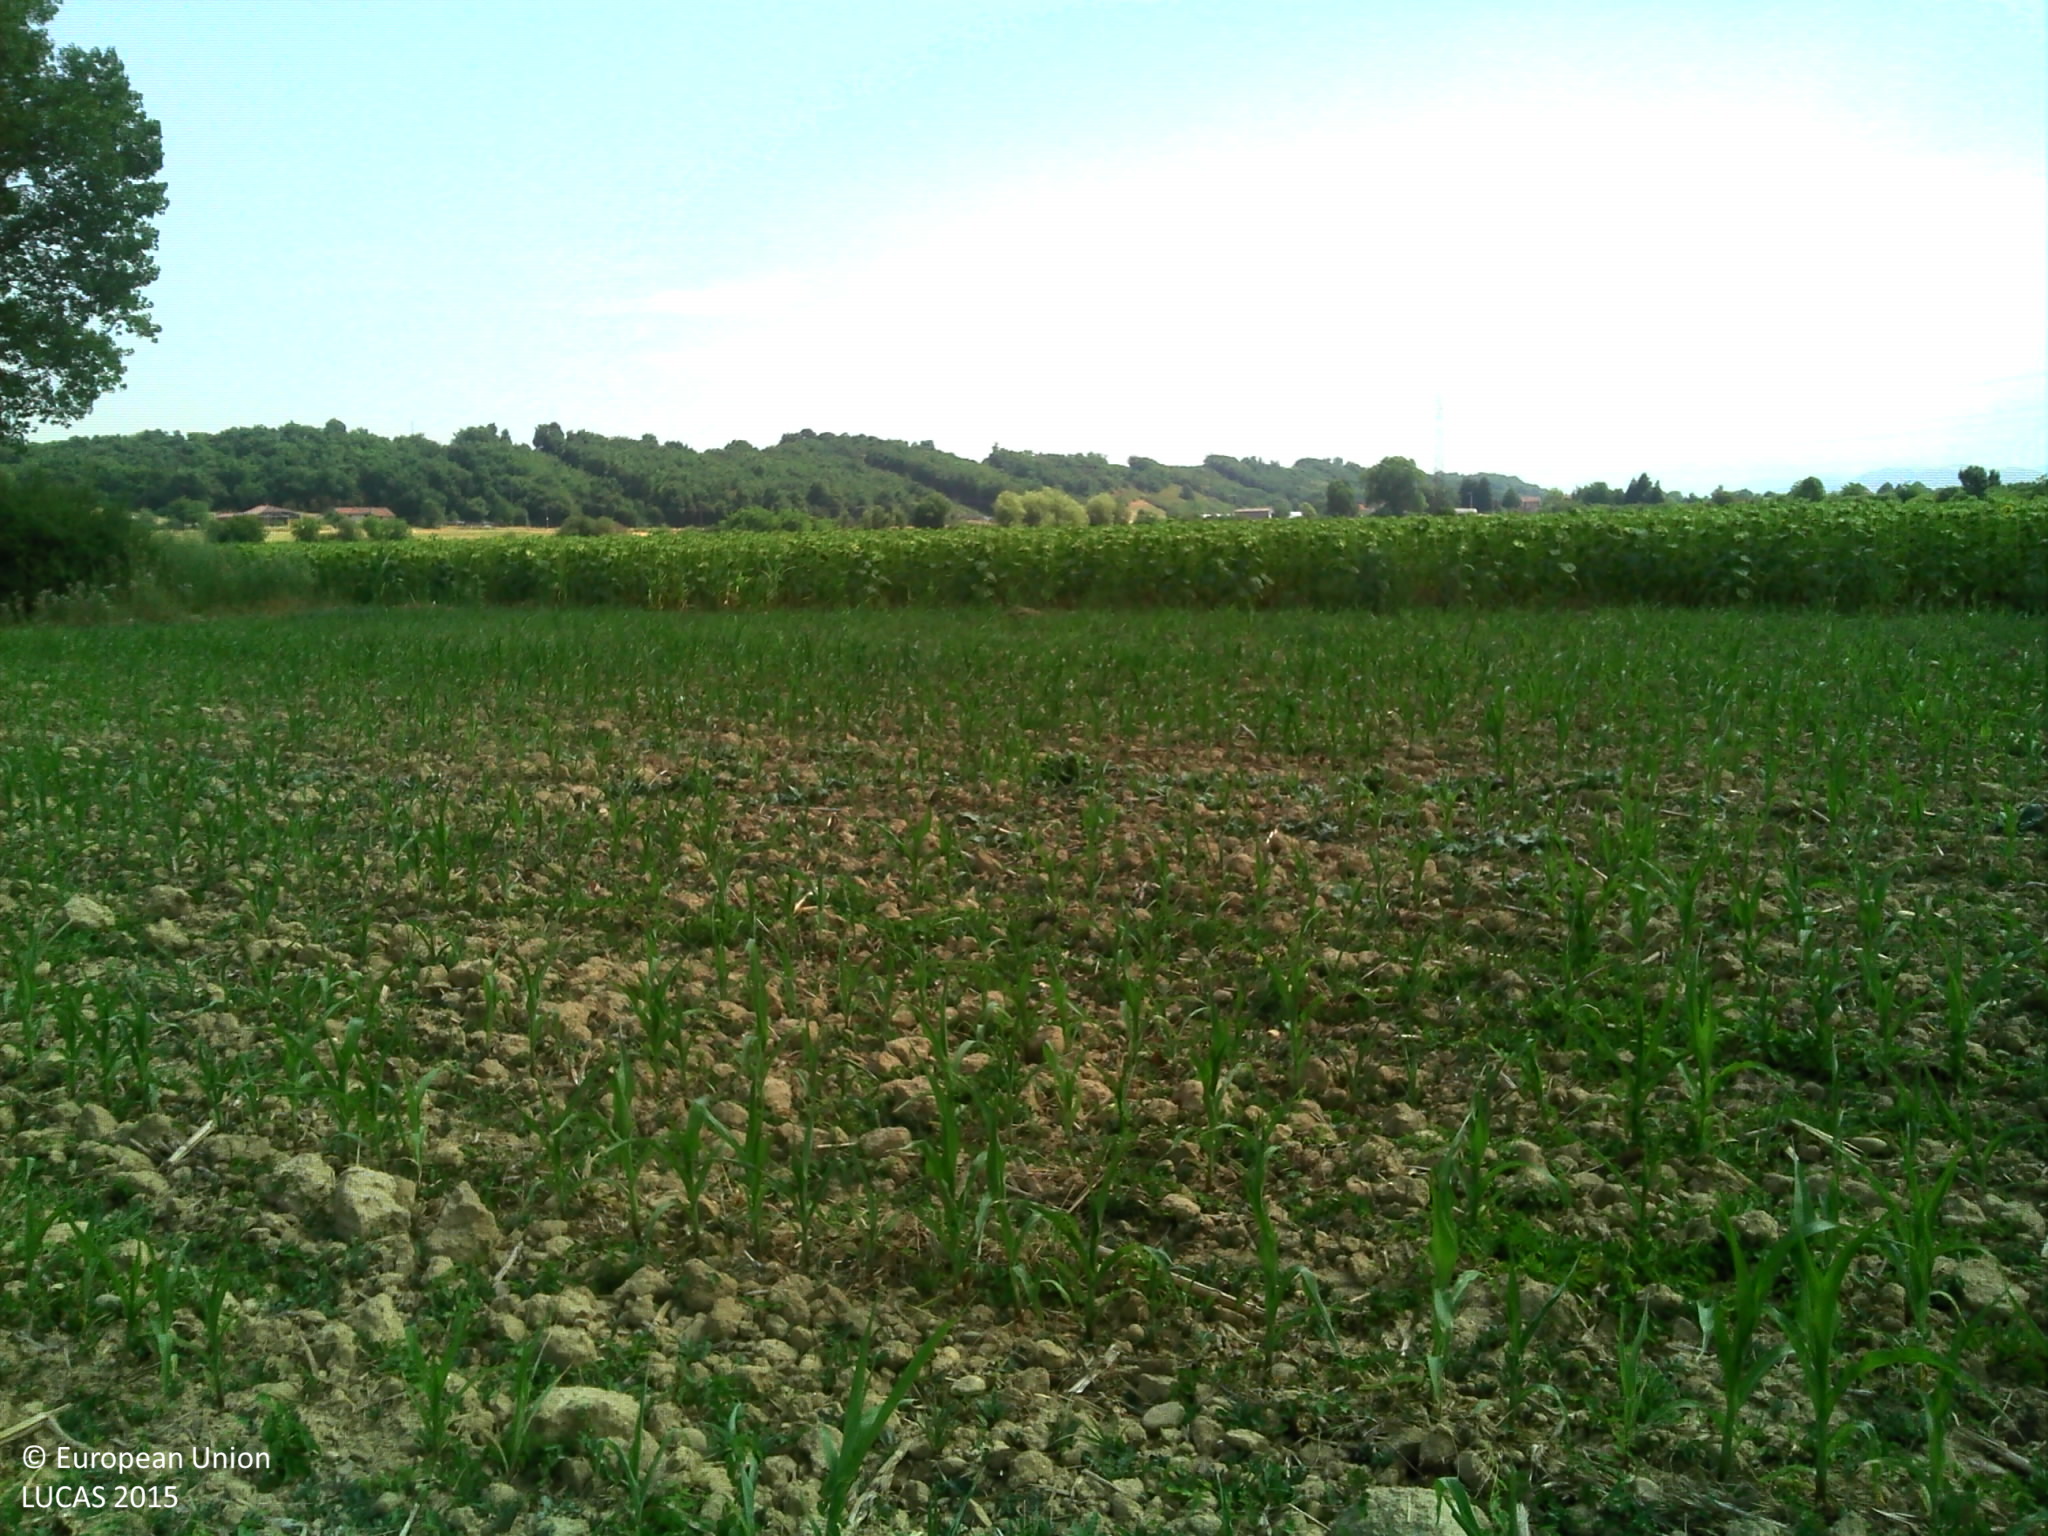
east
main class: Cropland
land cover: Maize
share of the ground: 50 - 75 %
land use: Agriculture (excluding fallow land and kitchen gardens)
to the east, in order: Maize; Sunflower; Rape and turnip rape; Grassland without tree/shrub cover
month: July
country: FR
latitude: 45.3373
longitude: 5.1174
